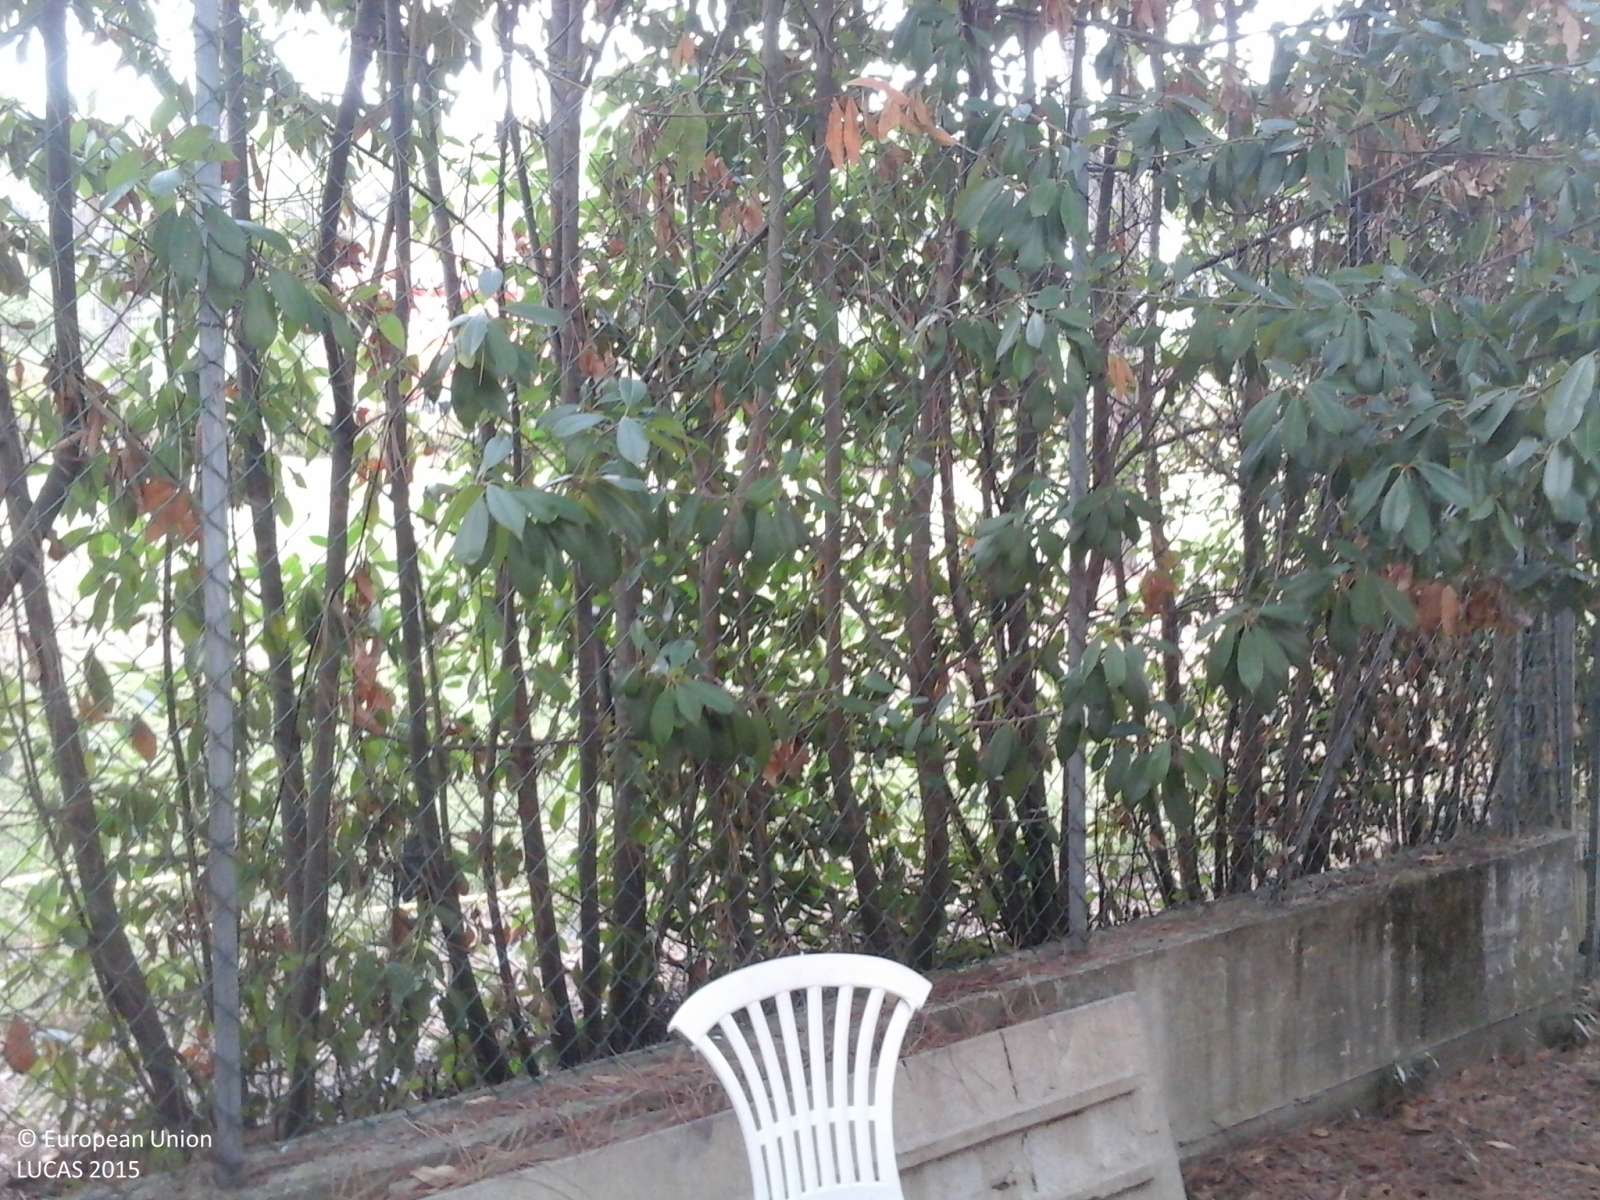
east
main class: Grassland
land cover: Grassland with sparse tree/shrub cover
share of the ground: > 75 %
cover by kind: herbaceous plants 95 %, coniferous forest trees 5 %
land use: Residential
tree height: > 5 m
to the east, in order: Grassland with sparse tree/shrub cover; Artificial constructions in urban areas; Broadleaved woodland
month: August
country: IT
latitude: 43.8791
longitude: 10.7076
